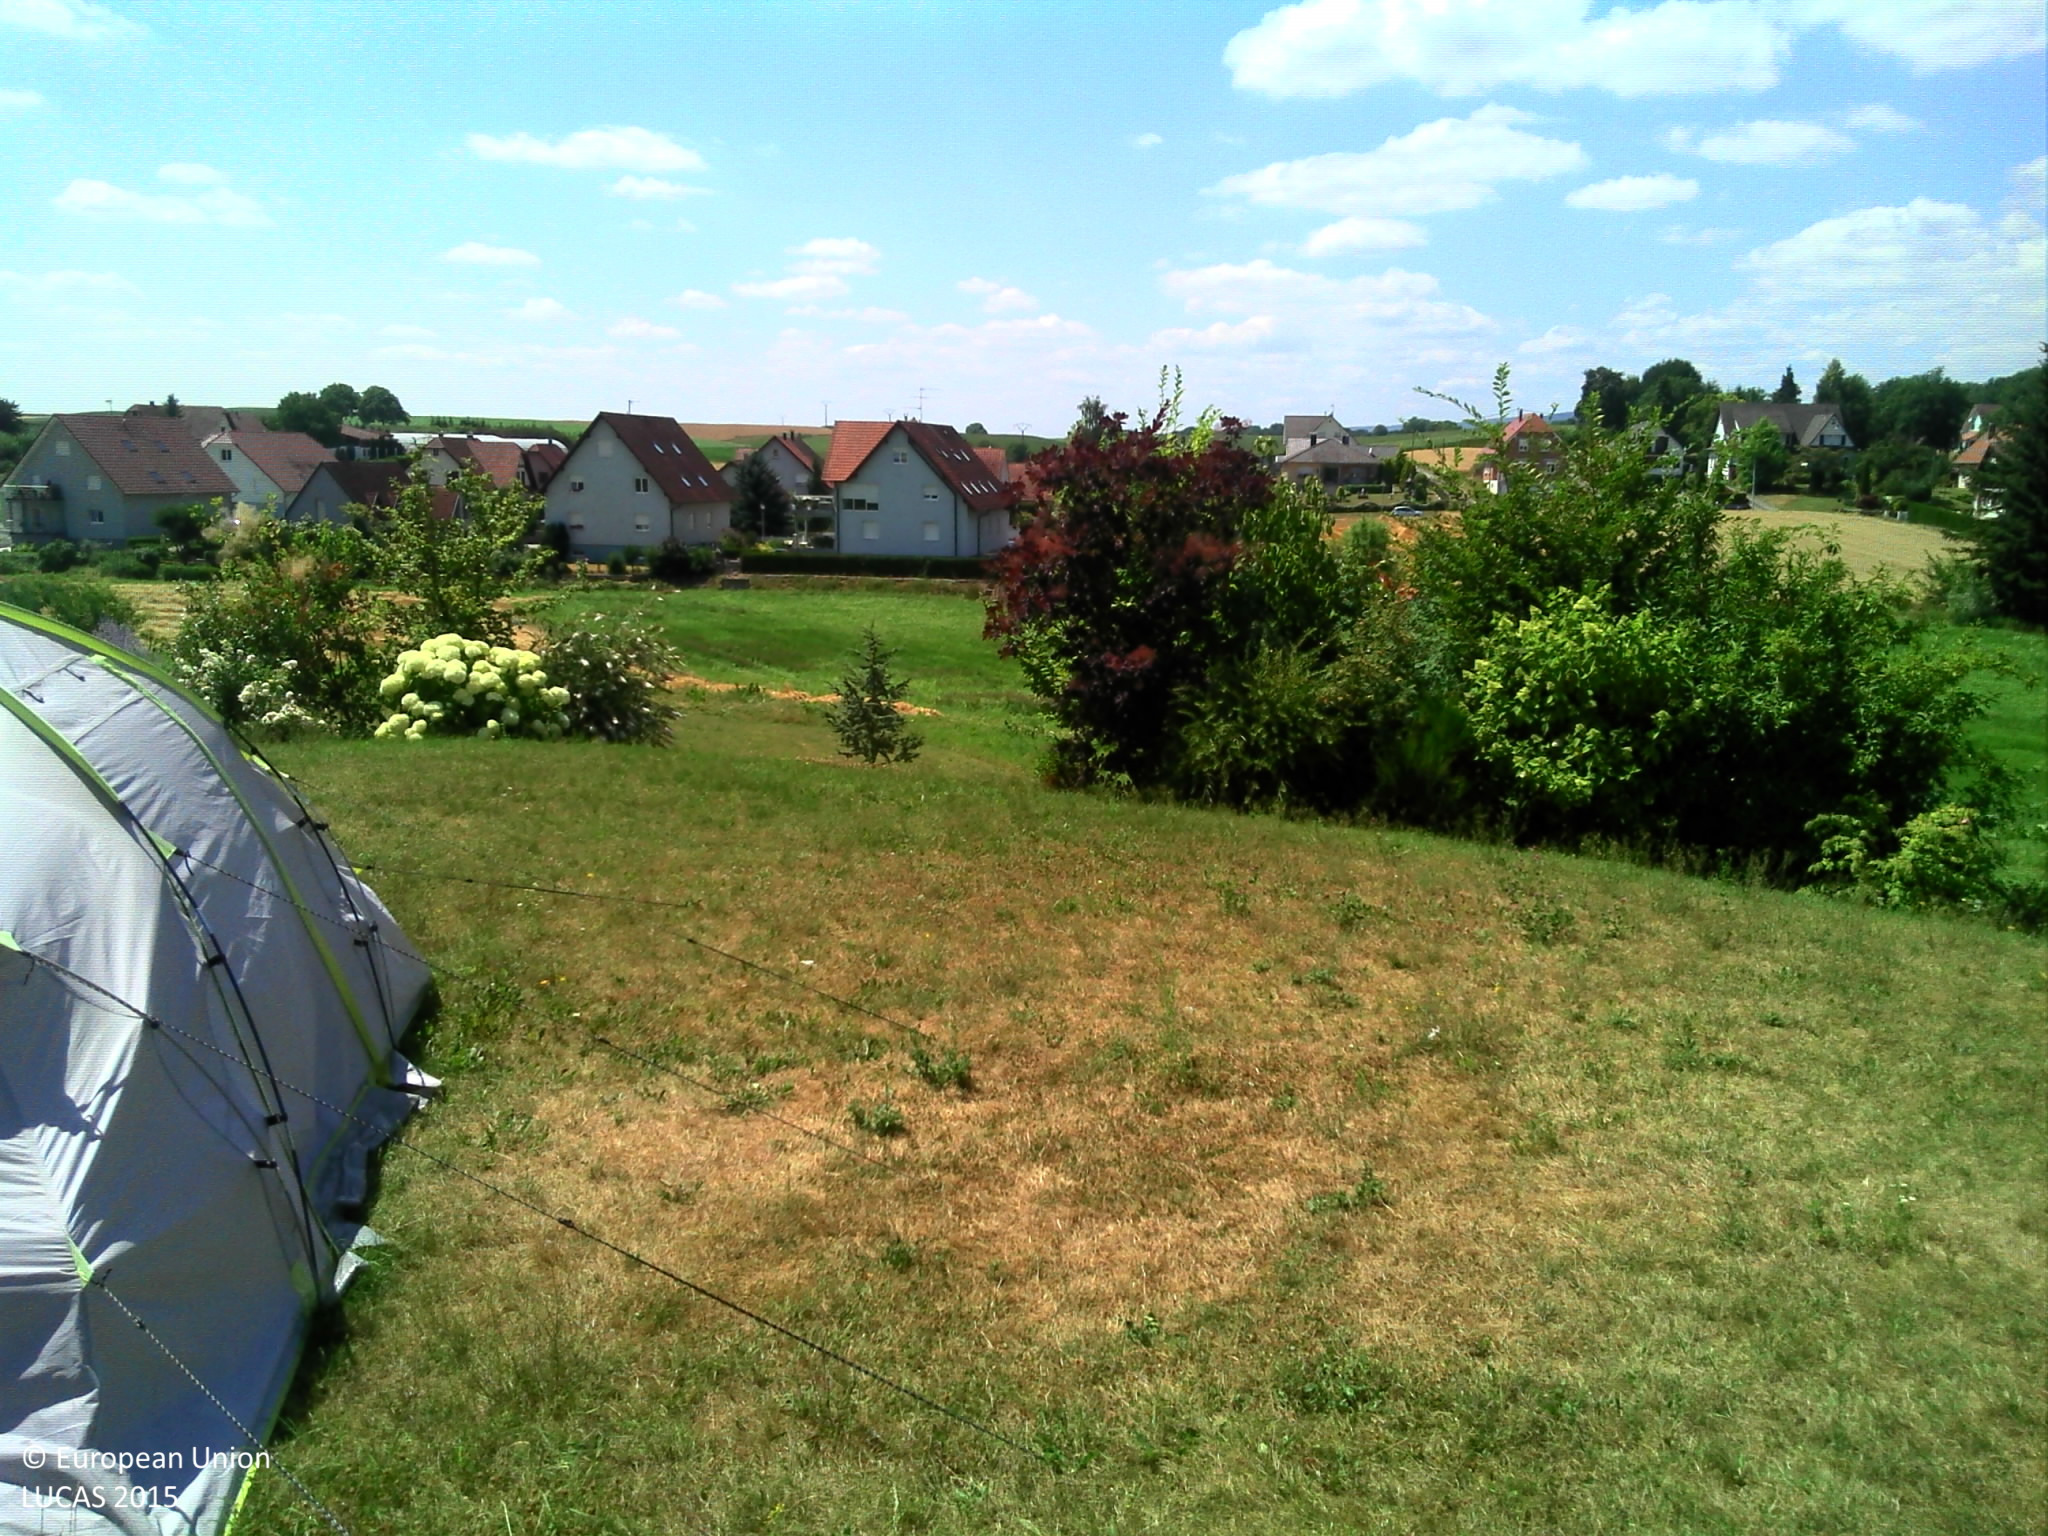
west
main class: Grassland
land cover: Grassland without tree/shrub cover
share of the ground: > 75 %
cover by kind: herbaceous plants 100 %
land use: Residential
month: July
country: FR
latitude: 48.9612
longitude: 7.9929
